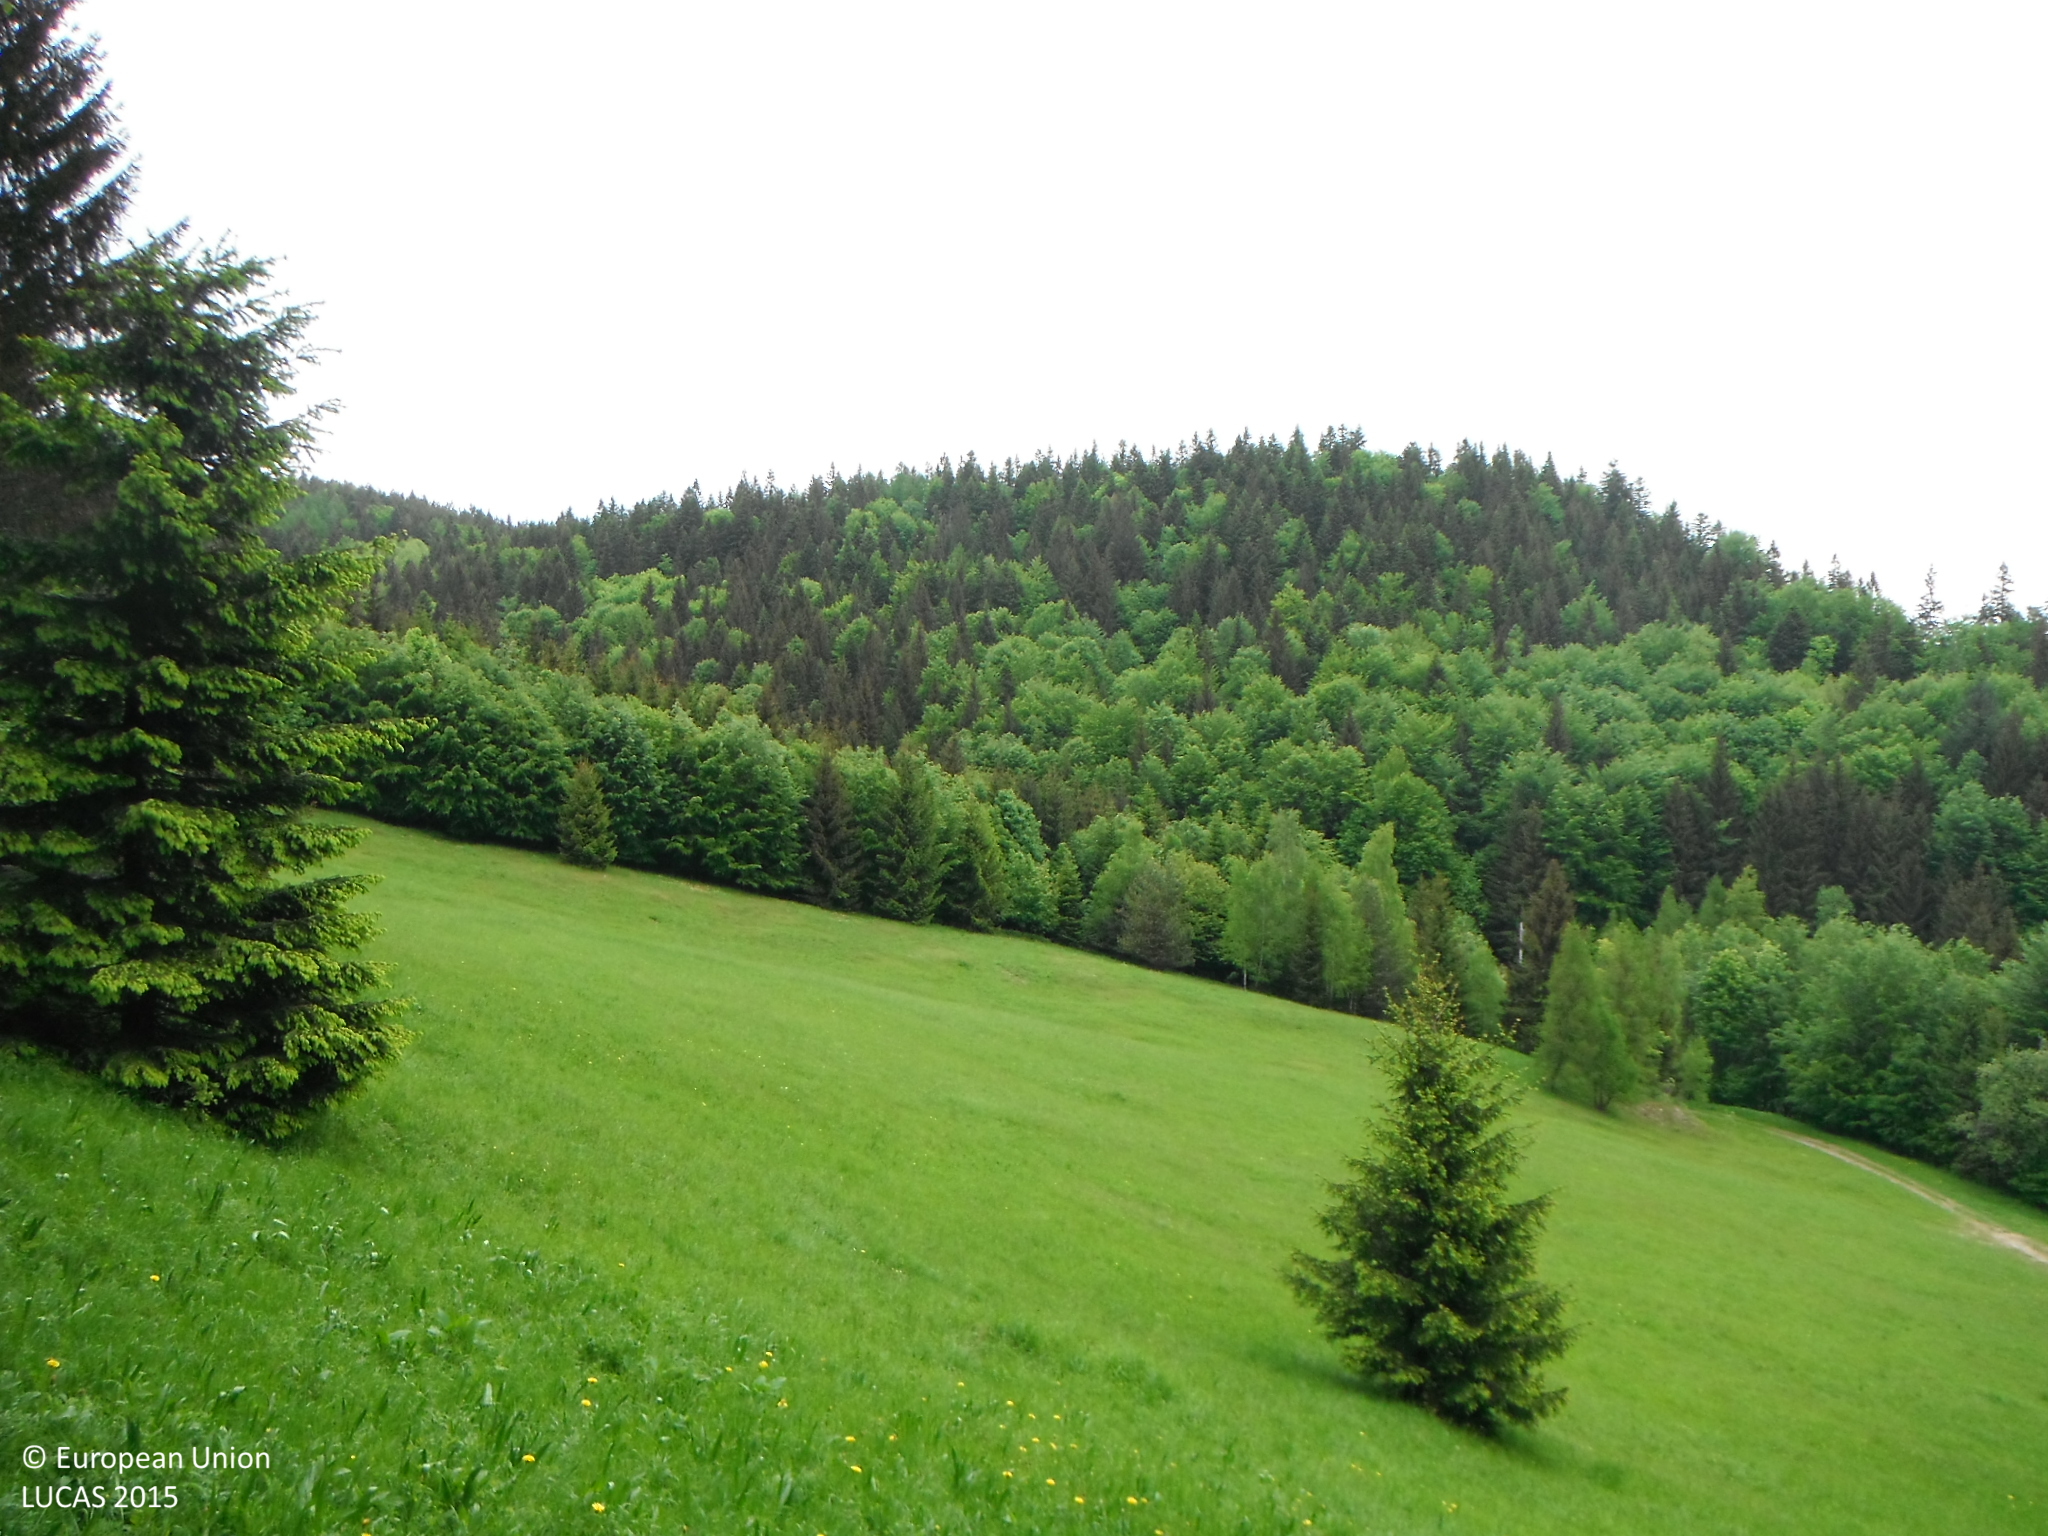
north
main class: Grassland
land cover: Grassland without tree/shrub cover
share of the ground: > 75 %
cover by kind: herbaceous plants 100 %
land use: Agriculture (excluding fallow land and kitchen gardens)
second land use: Sport
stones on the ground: < 10 %
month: May
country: SK
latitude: 48.8013
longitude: 19.1580
